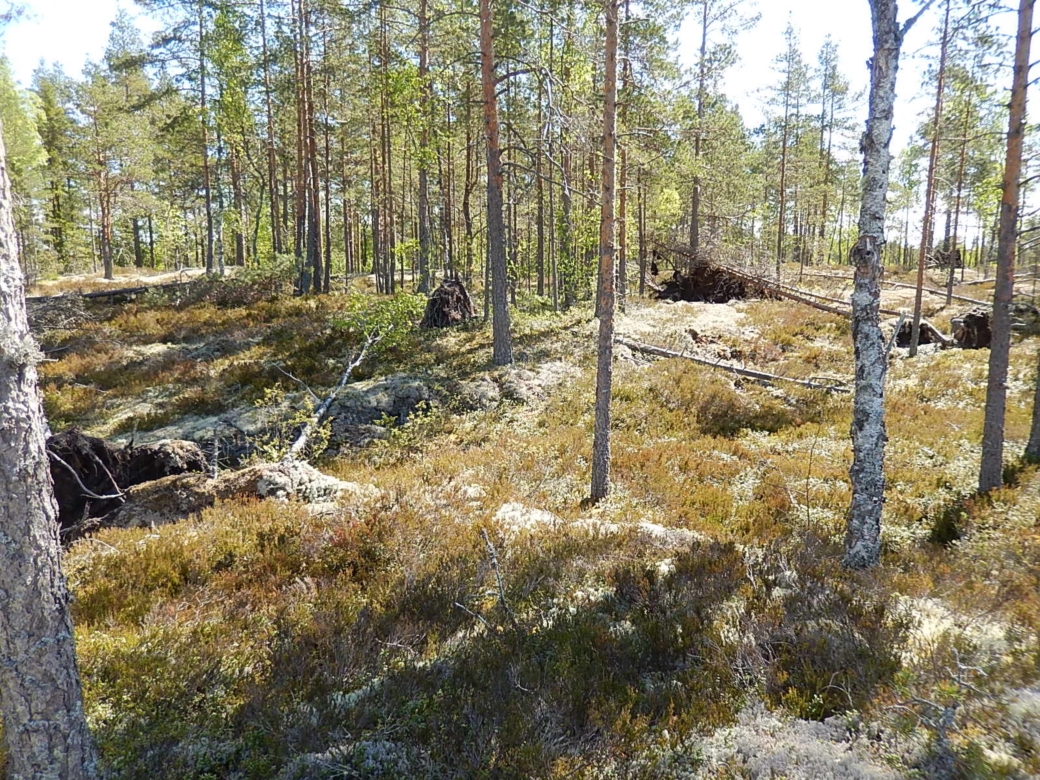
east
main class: Woodland
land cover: Pine dominated coniferous woodland
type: boreal forest
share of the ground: 50 - 75 %
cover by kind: coniferous forest trees 45 %, shrubs 25 %, lichens and mosses 25 %, broadleaved forest trees 5 %
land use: Forestry
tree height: > 5 m
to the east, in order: Pine dominated coniferous woodland; Pine dominated mixed woodland; Ditches and canals; Pine dominated mixed woodland; Pine dominated coniferous woodland; Ditches and canals; Pine dominated coniferous woodland
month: June
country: FI
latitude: 62.0544
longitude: 21.5816
